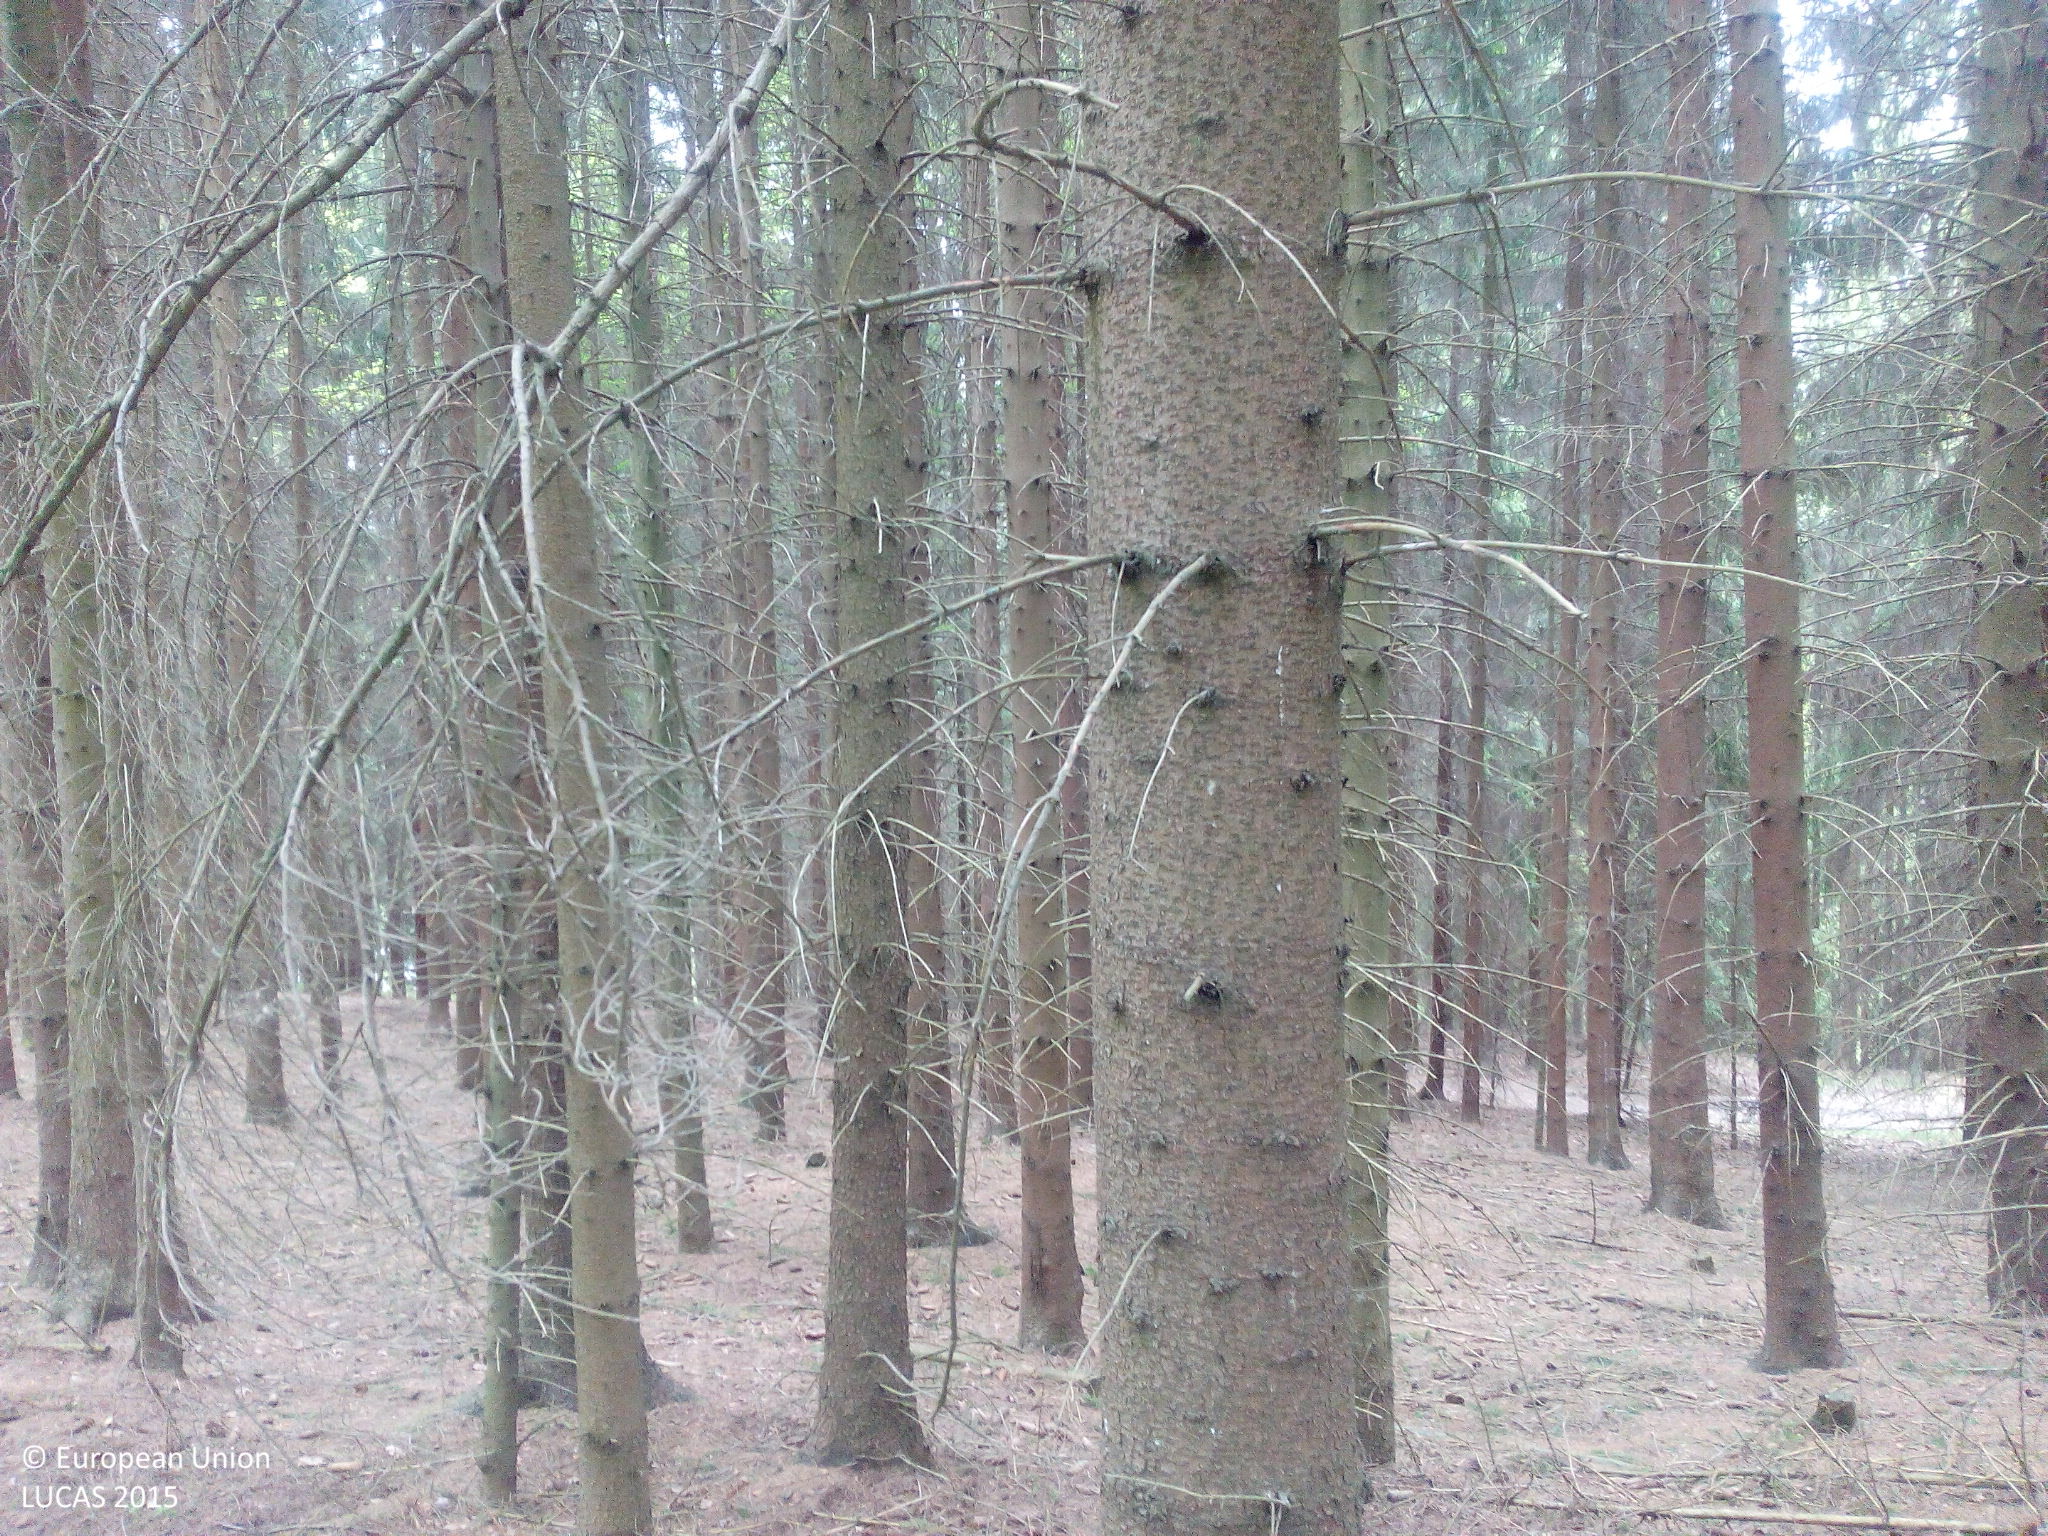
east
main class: Woodland
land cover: Spruce dominated coniferous woodland
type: hemiboreal forest and nemoral coniferous forest and mixed broadleaved-coniferous forest
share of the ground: > 75 %
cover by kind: coniferous forest trees 100 %
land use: Forestry
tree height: > 5 m
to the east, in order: Spruce dominated coniferous woodland; Tracks; Spruce dominated coniferous woodland; Tracks; Spruce dominated coniferous woodland; Artificial constructions in urban areas
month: May
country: DE
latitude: 50.7201
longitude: 13.0170
